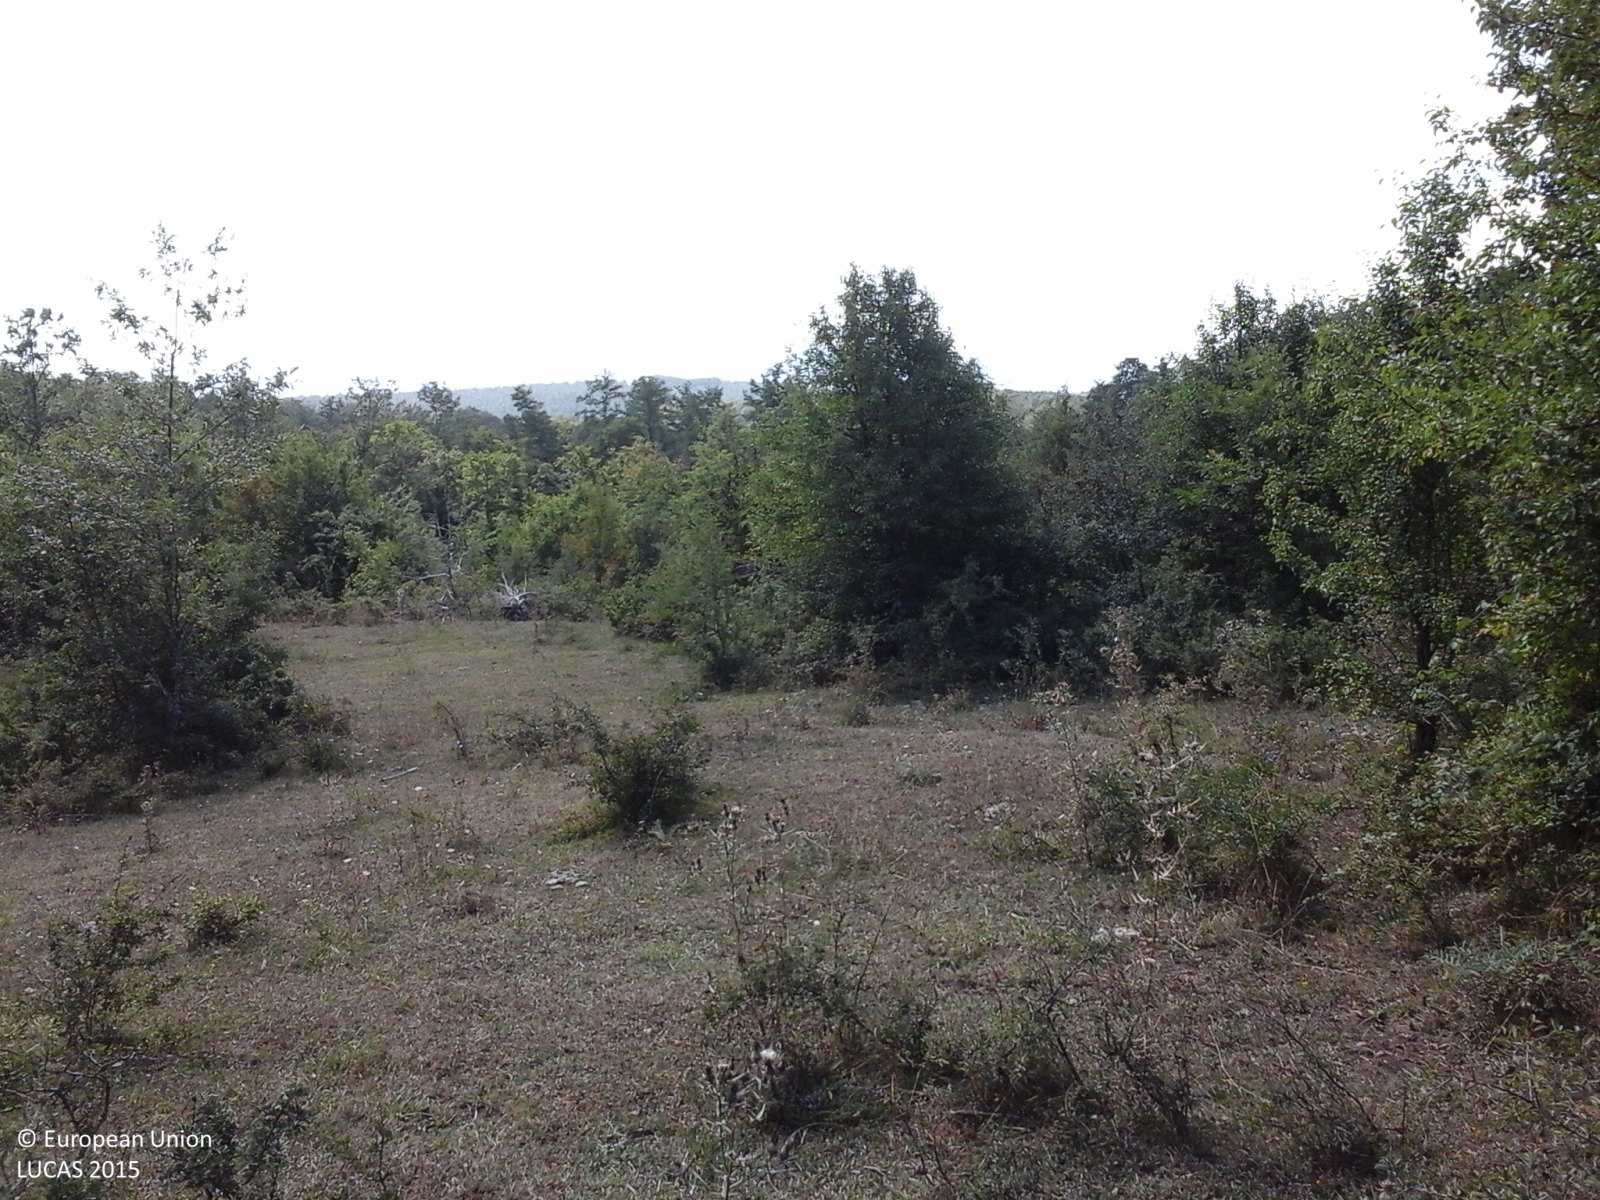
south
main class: Shrubland
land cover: Shrubland with sparse tree cover
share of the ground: > 75 %
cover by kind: herbaceous plants 50 %, shrubs 45 %, broadleaved forest trees 5 %
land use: Agriculture (excluding fallow land and kitchen gardens)
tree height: < 5 m
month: August
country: IT
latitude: 41.7666
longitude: 14.3036
